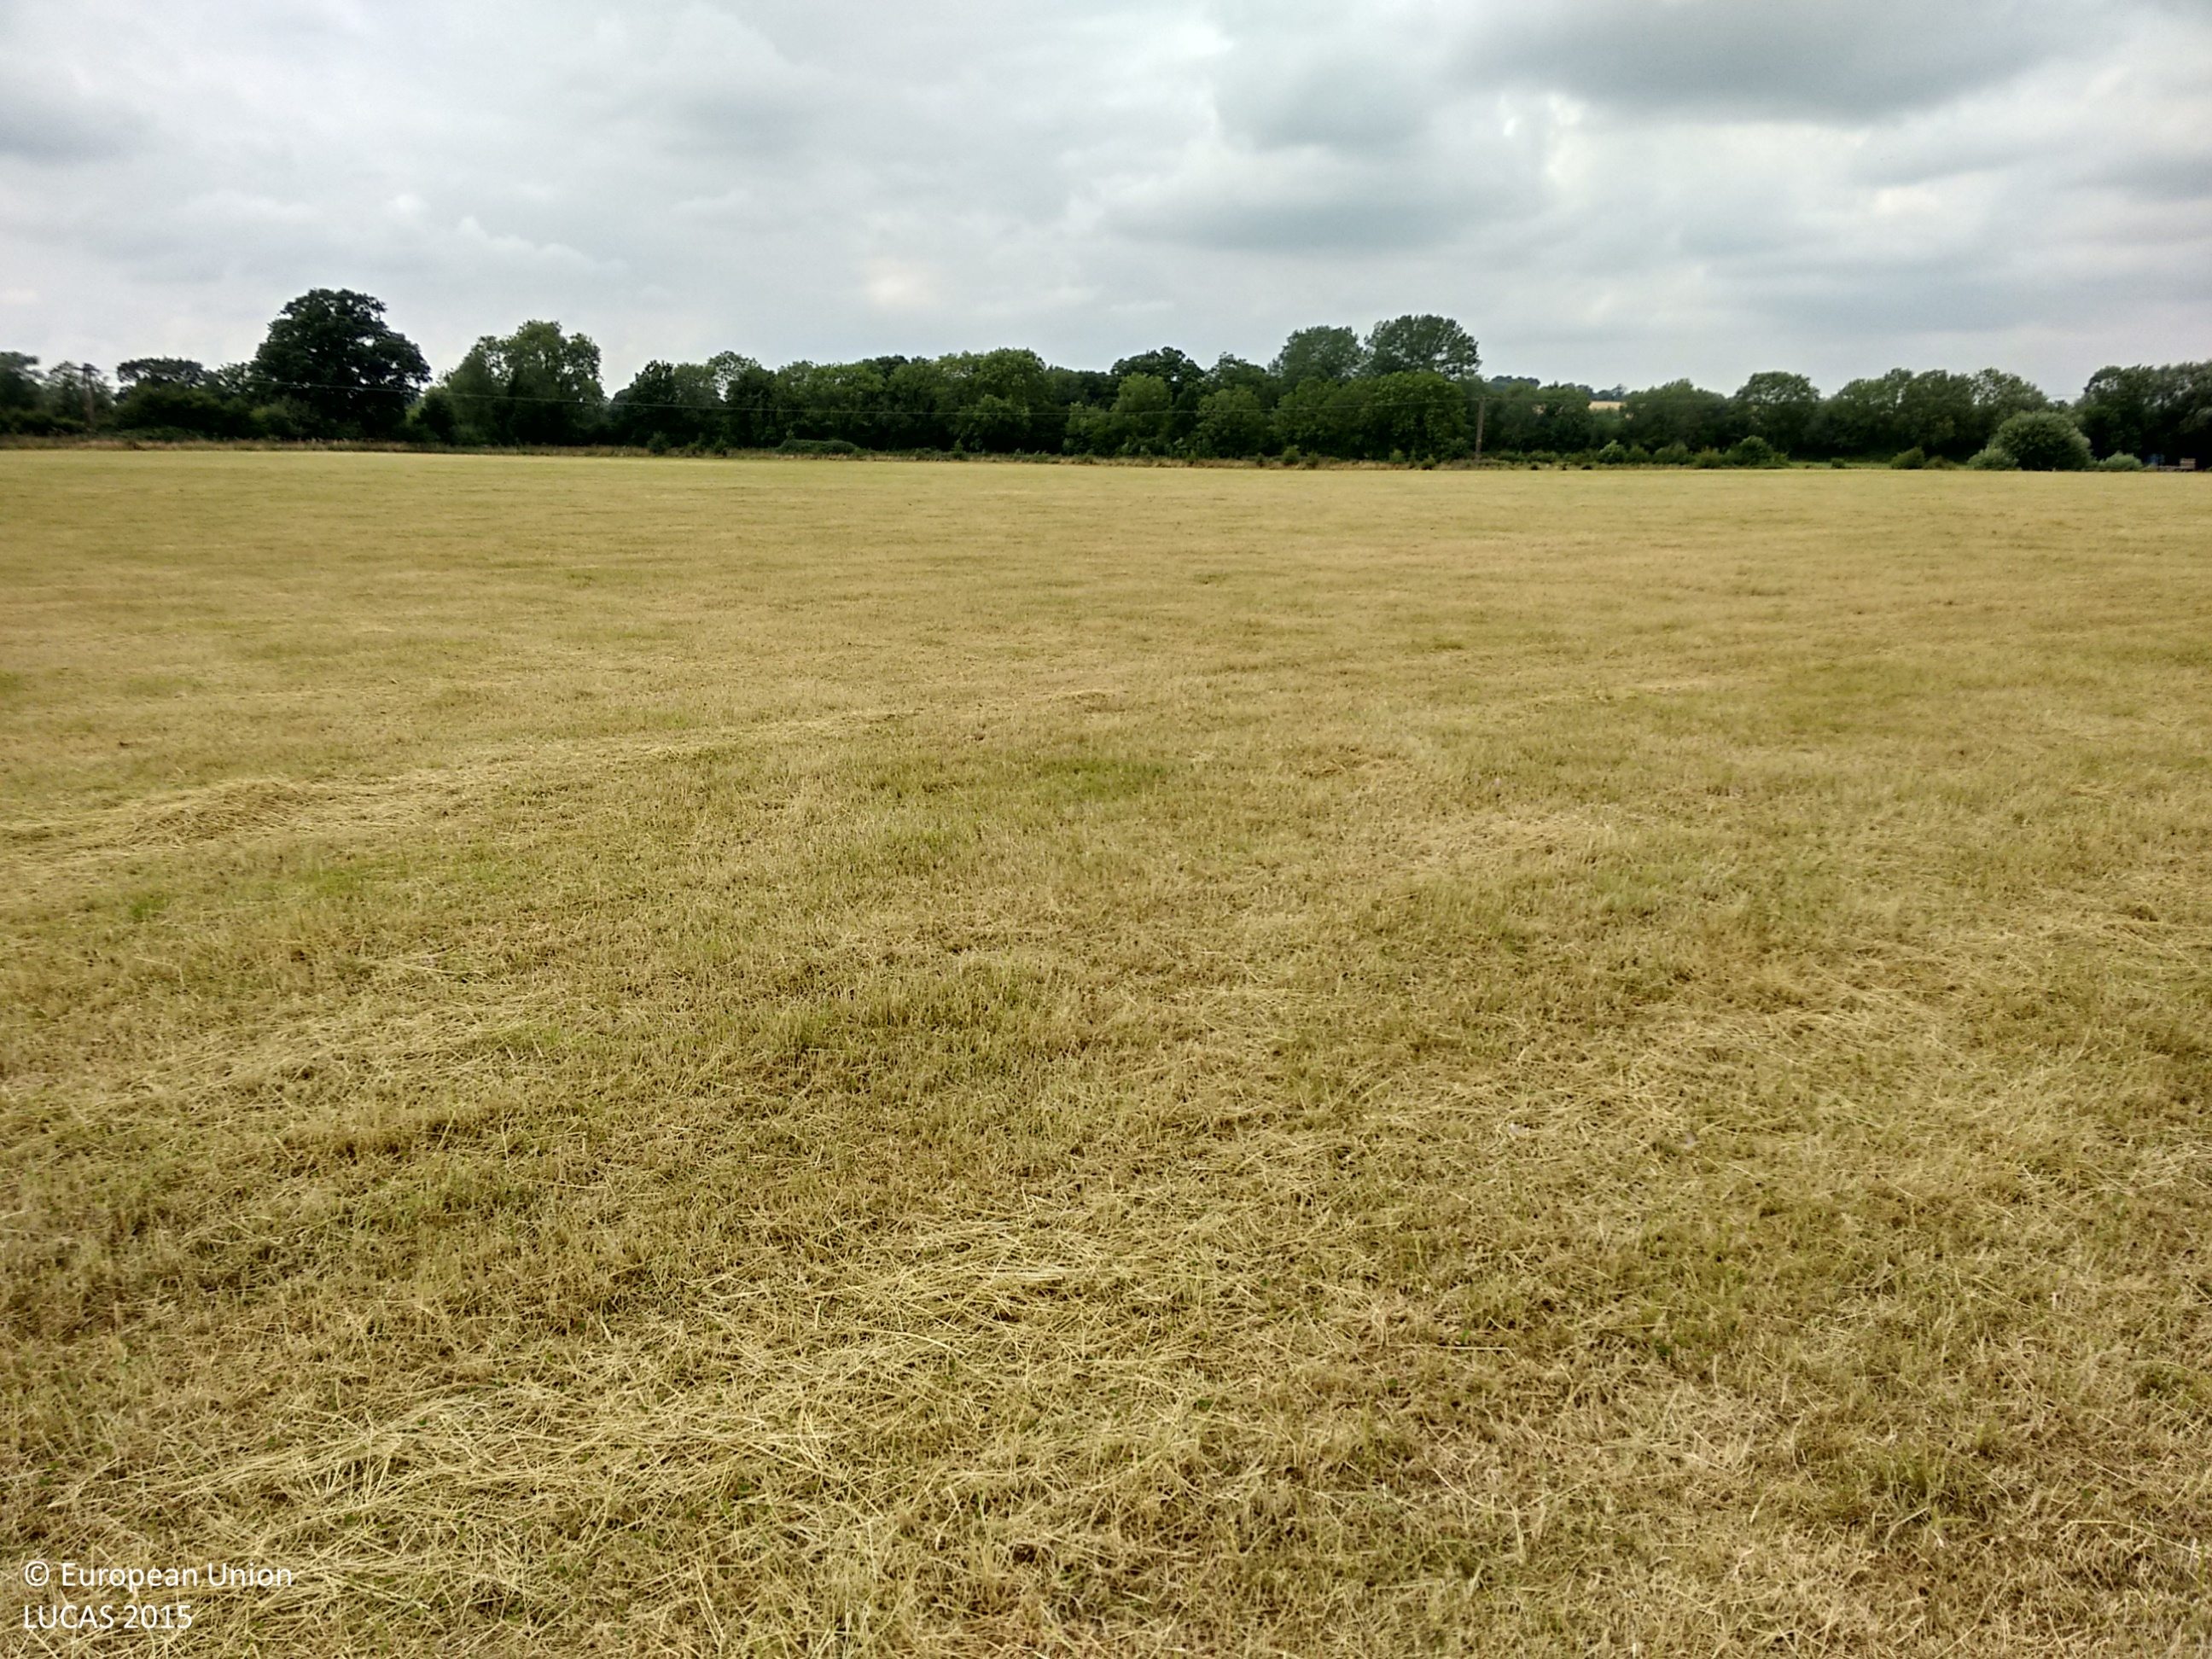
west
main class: Grassland
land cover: Grassland without tree/shrub cover
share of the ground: > 75 %
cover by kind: herbaceous plants 100 %
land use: Agriculture (excluding fallow land and kitchen gardens)
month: July
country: GB
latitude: 51.8092
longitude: -1.2007
